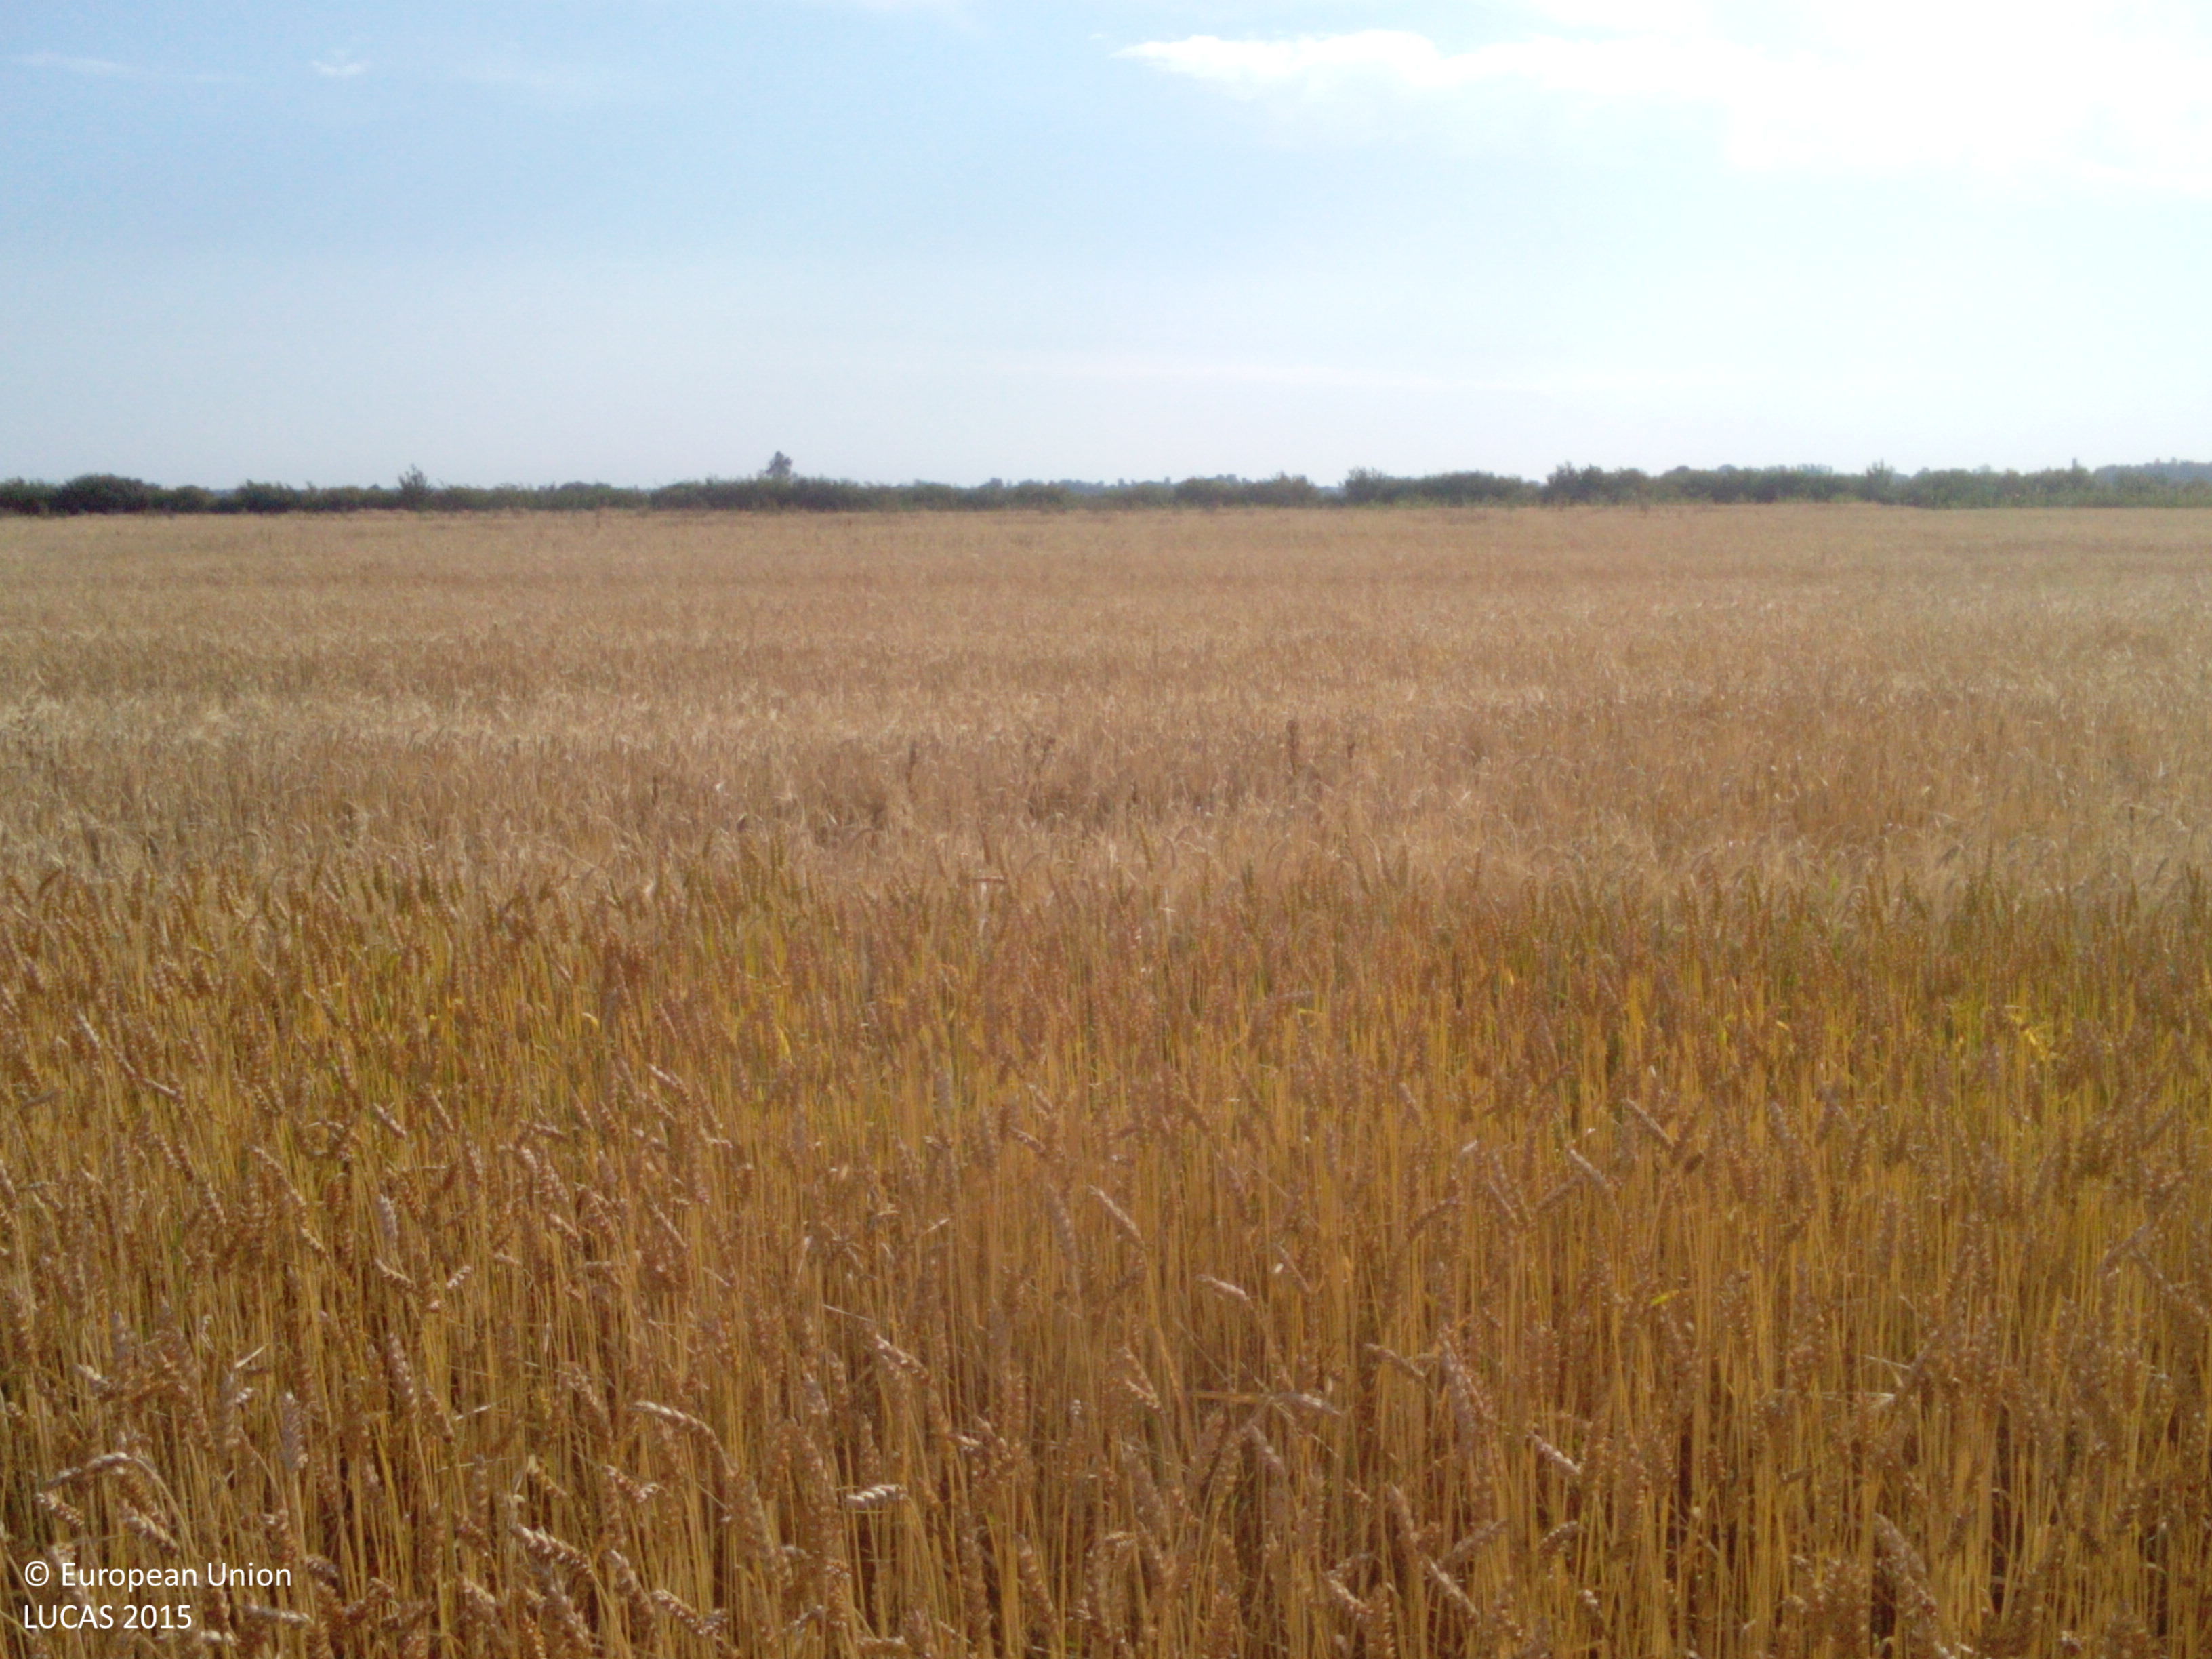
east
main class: Cropland
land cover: Common wheat
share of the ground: > 75 %
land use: Agriculture (excluding fallow land and kitchen gardens)
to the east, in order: Common wheat; Barley; Spontaneously vegetated surfaces; Ditches and canals; Spontaneously vegetated surfaces; Arable land (only in case pi)
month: August
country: LV
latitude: 56.3798
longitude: 21.0652
